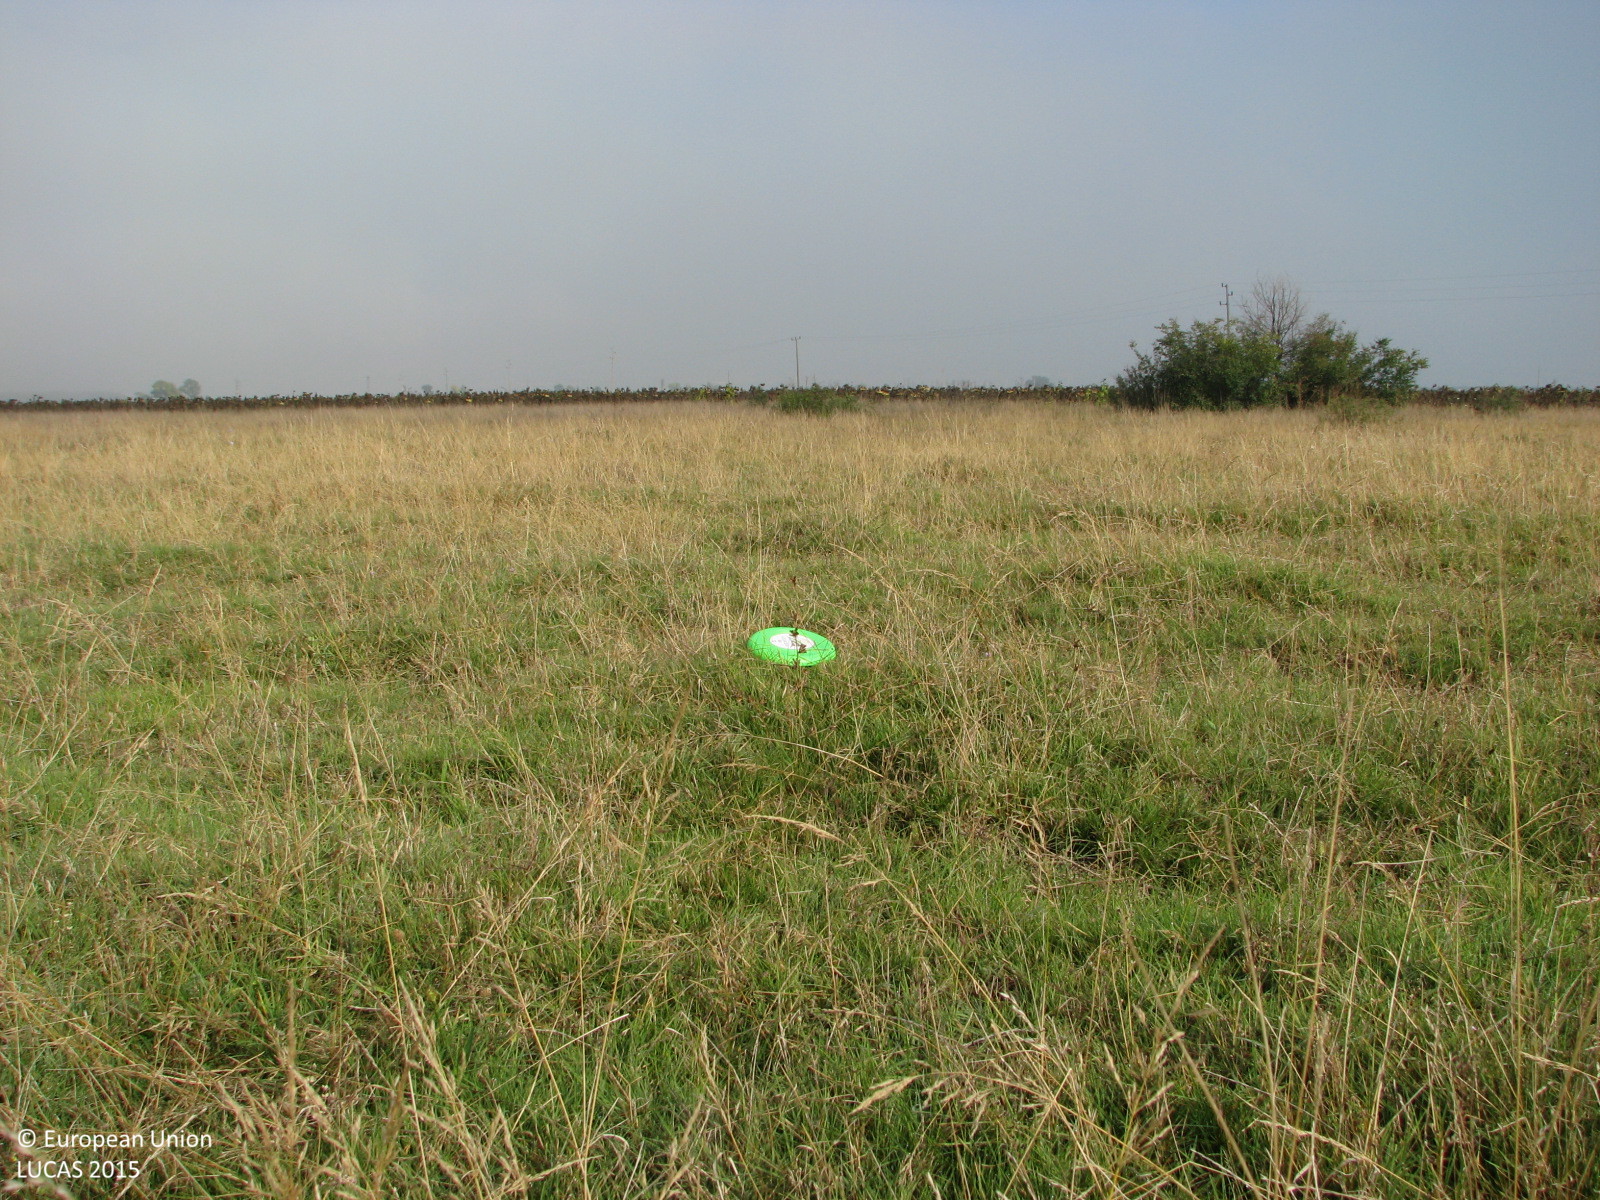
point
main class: Grassland
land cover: Grassland without tree/shrub cover
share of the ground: > 75 %
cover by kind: herbaceous plants 100 %
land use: Agriculture (excluding fallow land and kitchen gardens)
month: October
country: BG
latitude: 42.4192
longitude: 25.8883
